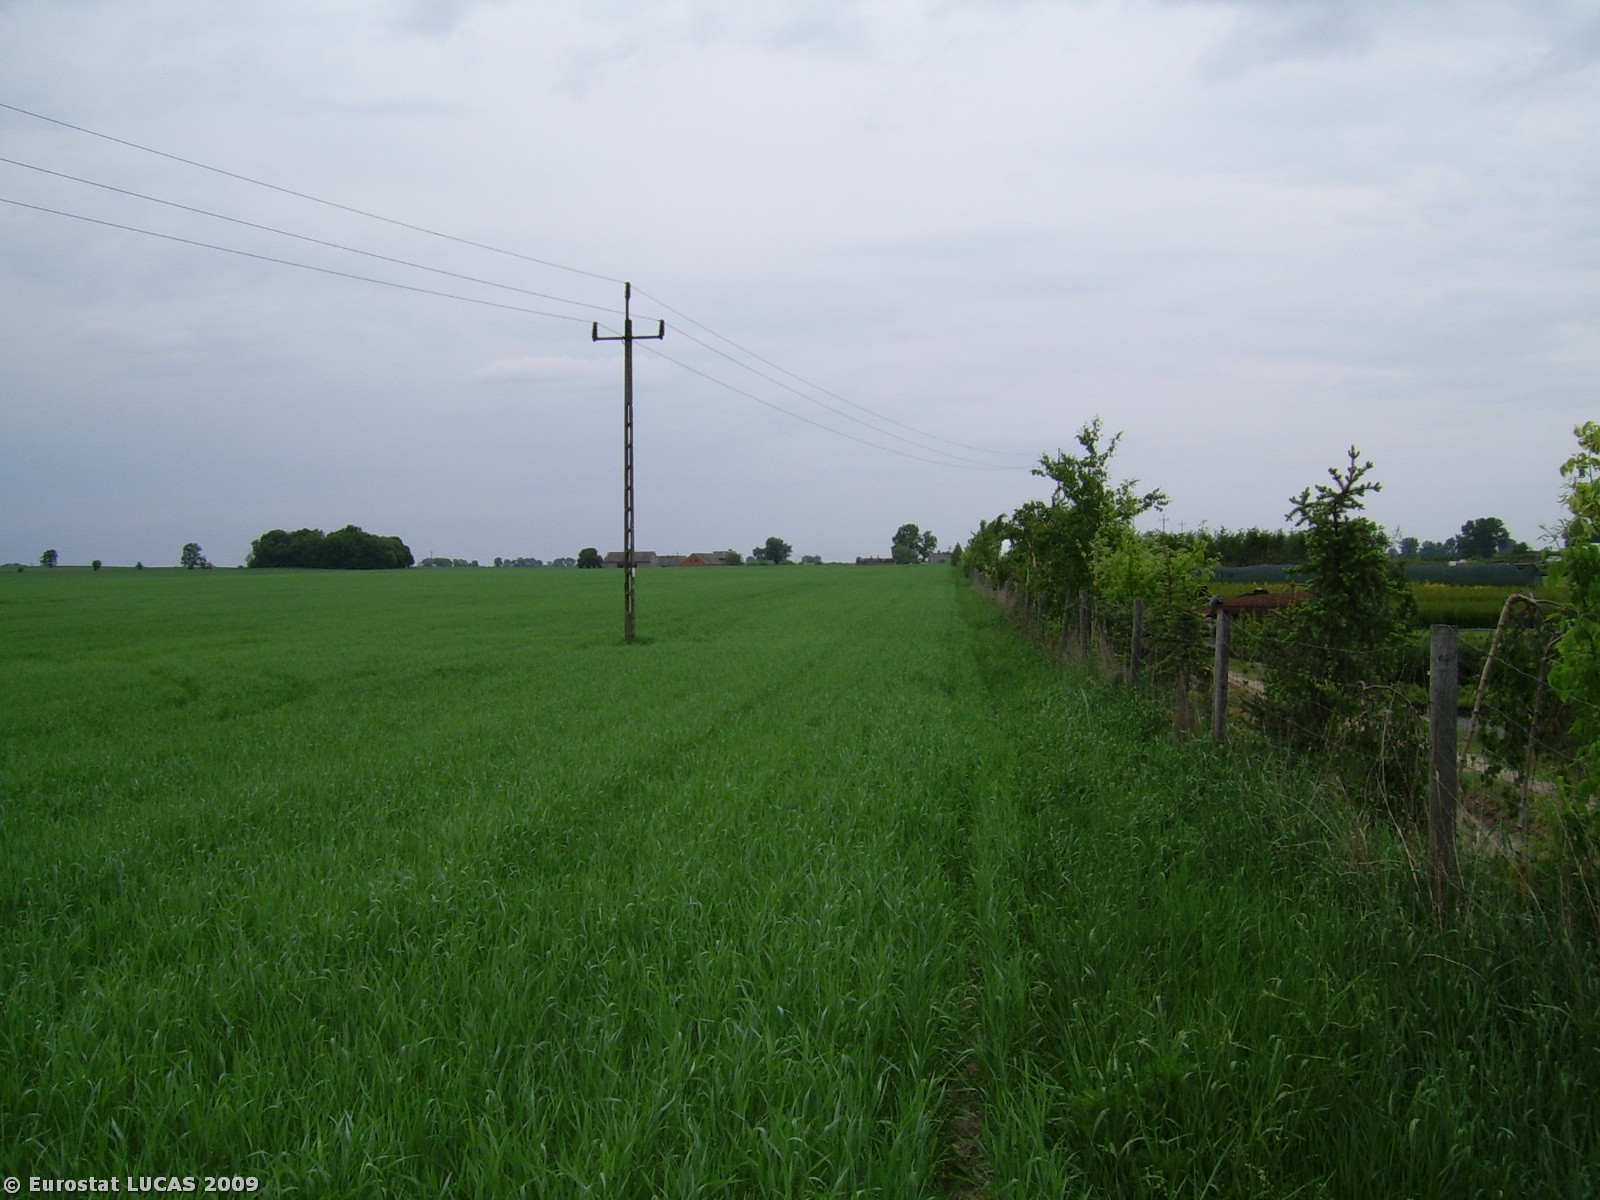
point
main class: Cropland
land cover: Rye
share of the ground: > 75 %
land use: Agriculture (excluding fallow land and kitchen gardens)
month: May
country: PL
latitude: 52.7238
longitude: 17.9661
